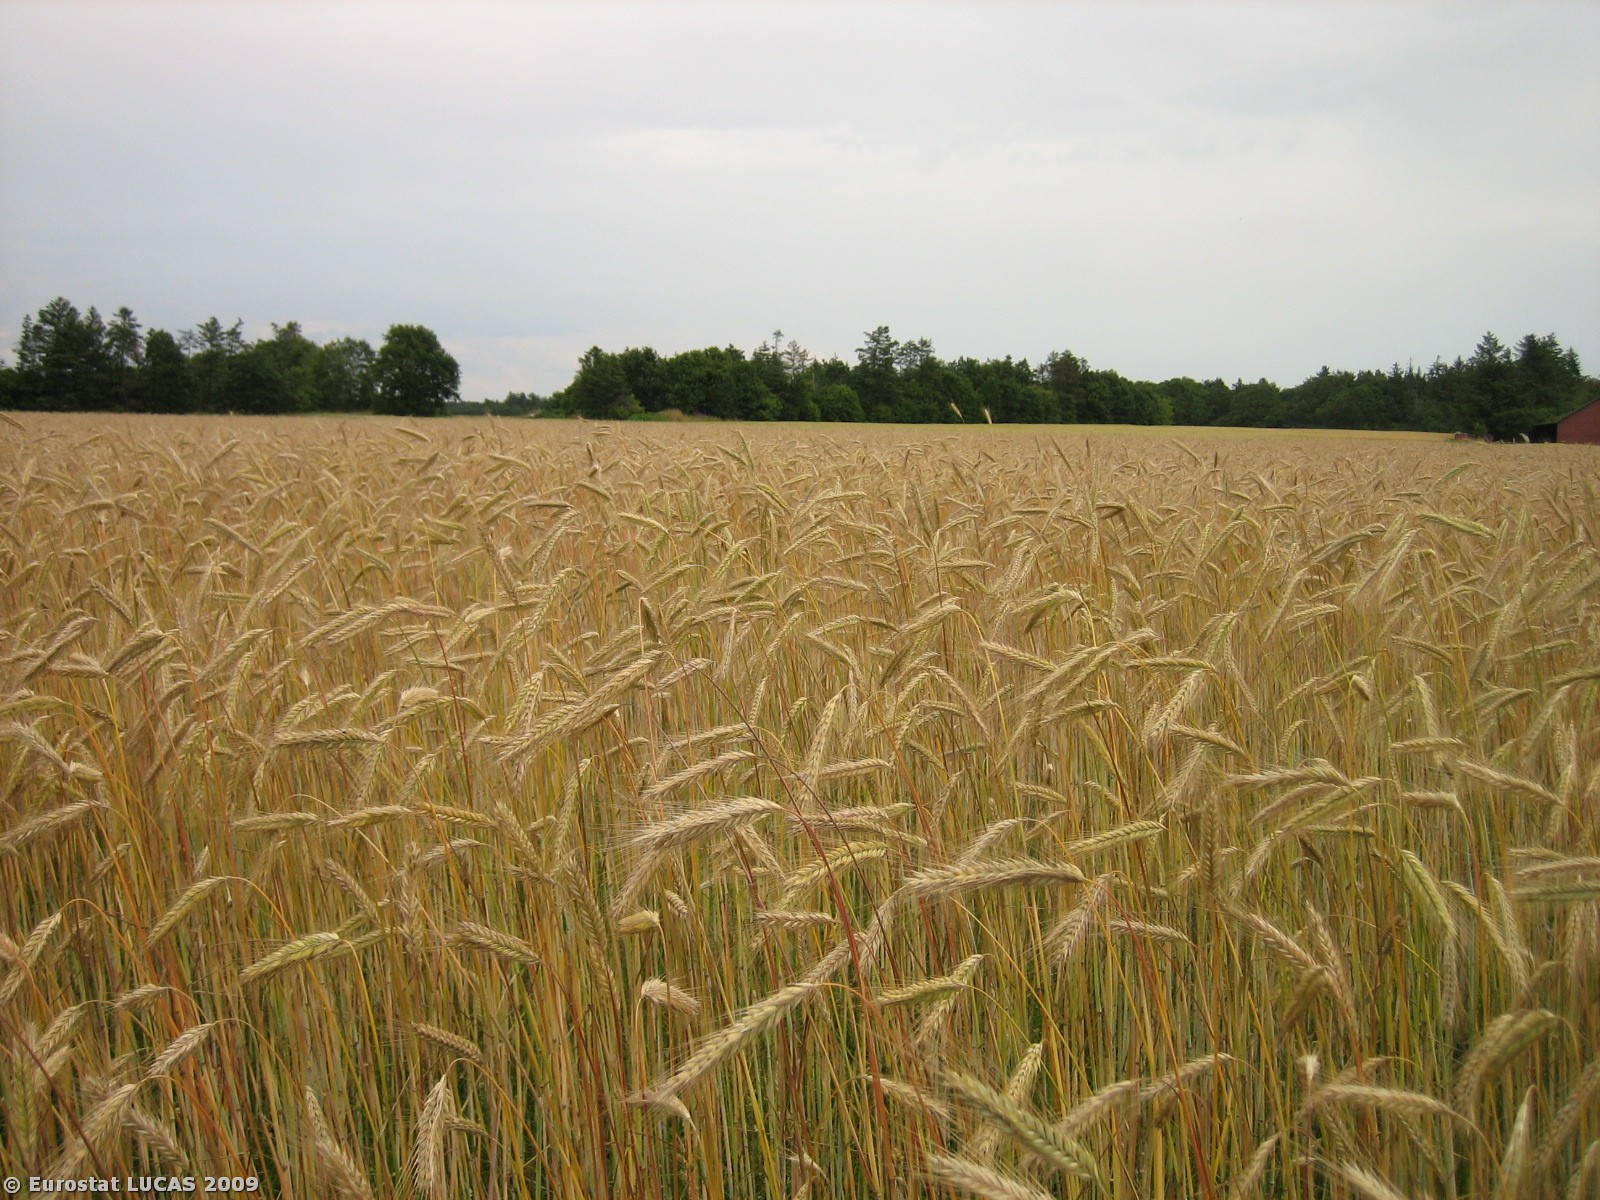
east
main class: Cropland
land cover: Rye
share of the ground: > 75 %
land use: Agriculture (excluding fallow land and kitchen gardens)
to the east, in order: Rye; Tracks; Rye; Broadleaved woodland
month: July
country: DK
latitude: 55.8580
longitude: 8.7392
